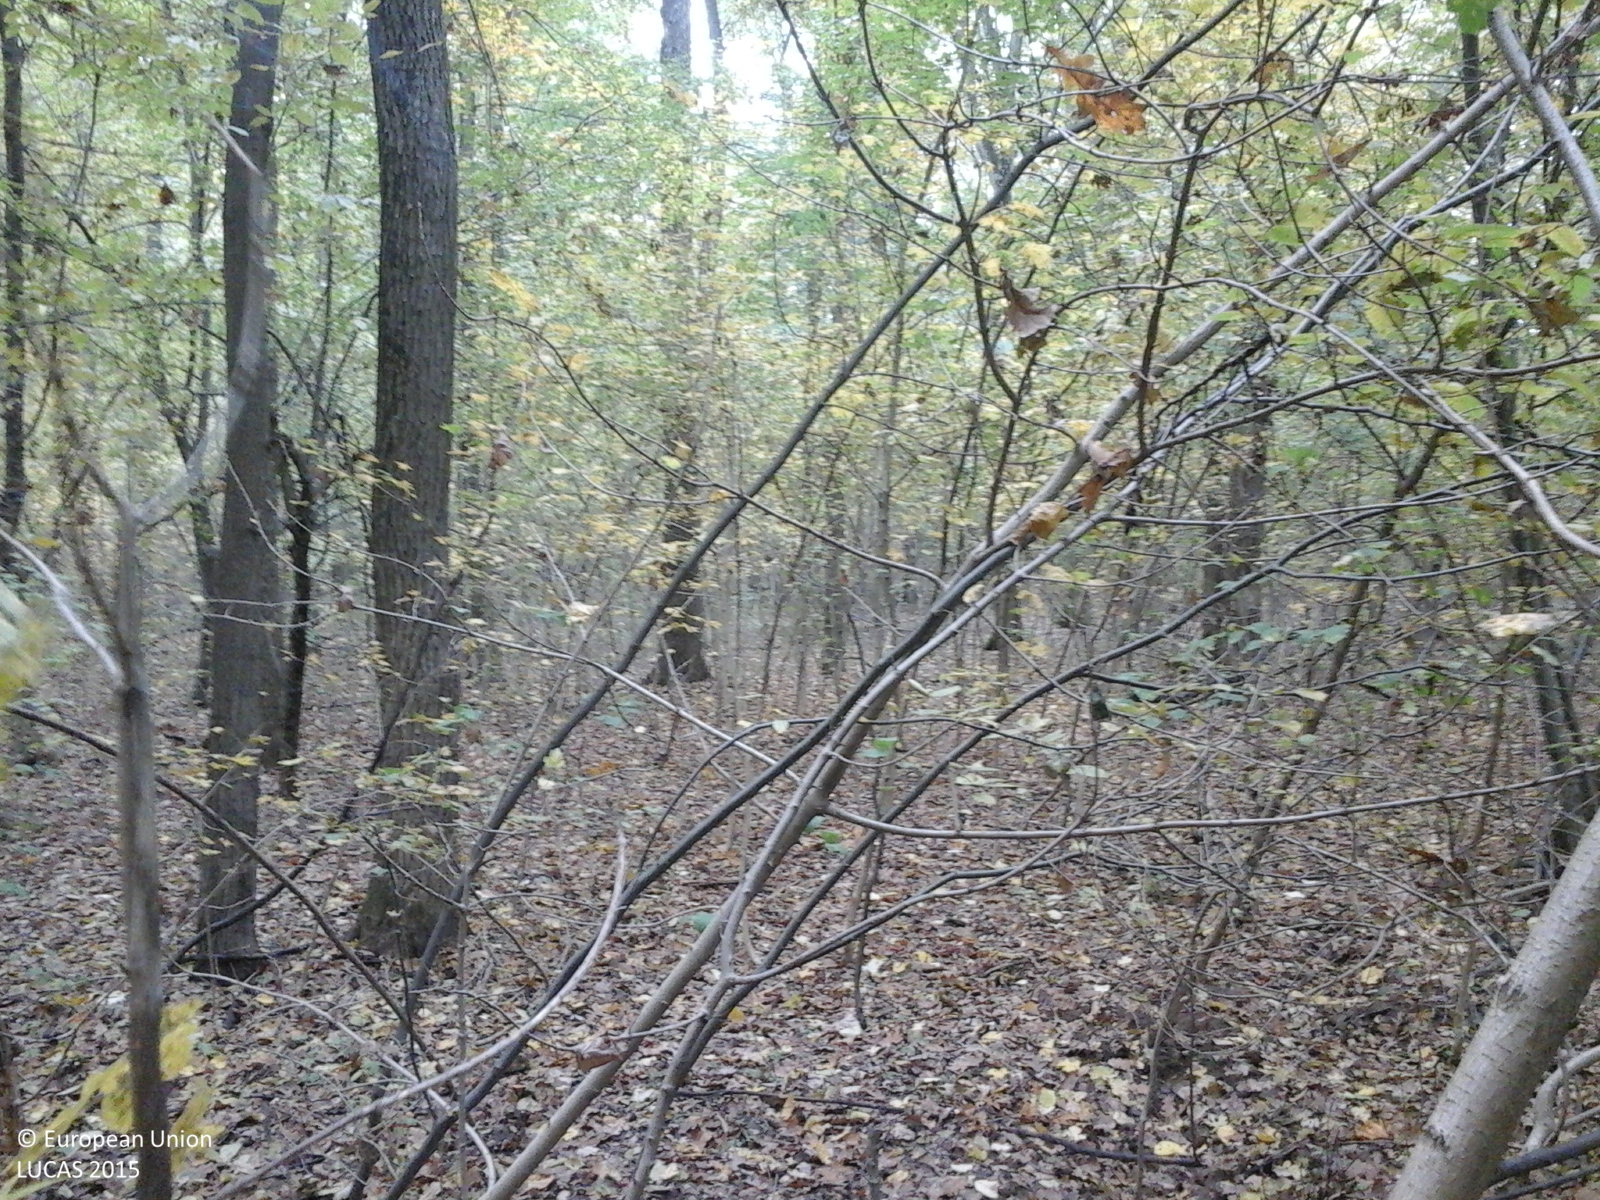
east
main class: Woodland
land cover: Broadleaved woodland
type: beech forest
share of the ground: > 75 %
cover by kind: broadleaved forest trees 100 %
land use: Forestry
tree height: > 5 m
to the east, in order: Broadleaved woodland; Tracks; Broadleaved woodland
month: October
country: RO
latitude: 44.7287
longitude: 26.0282
